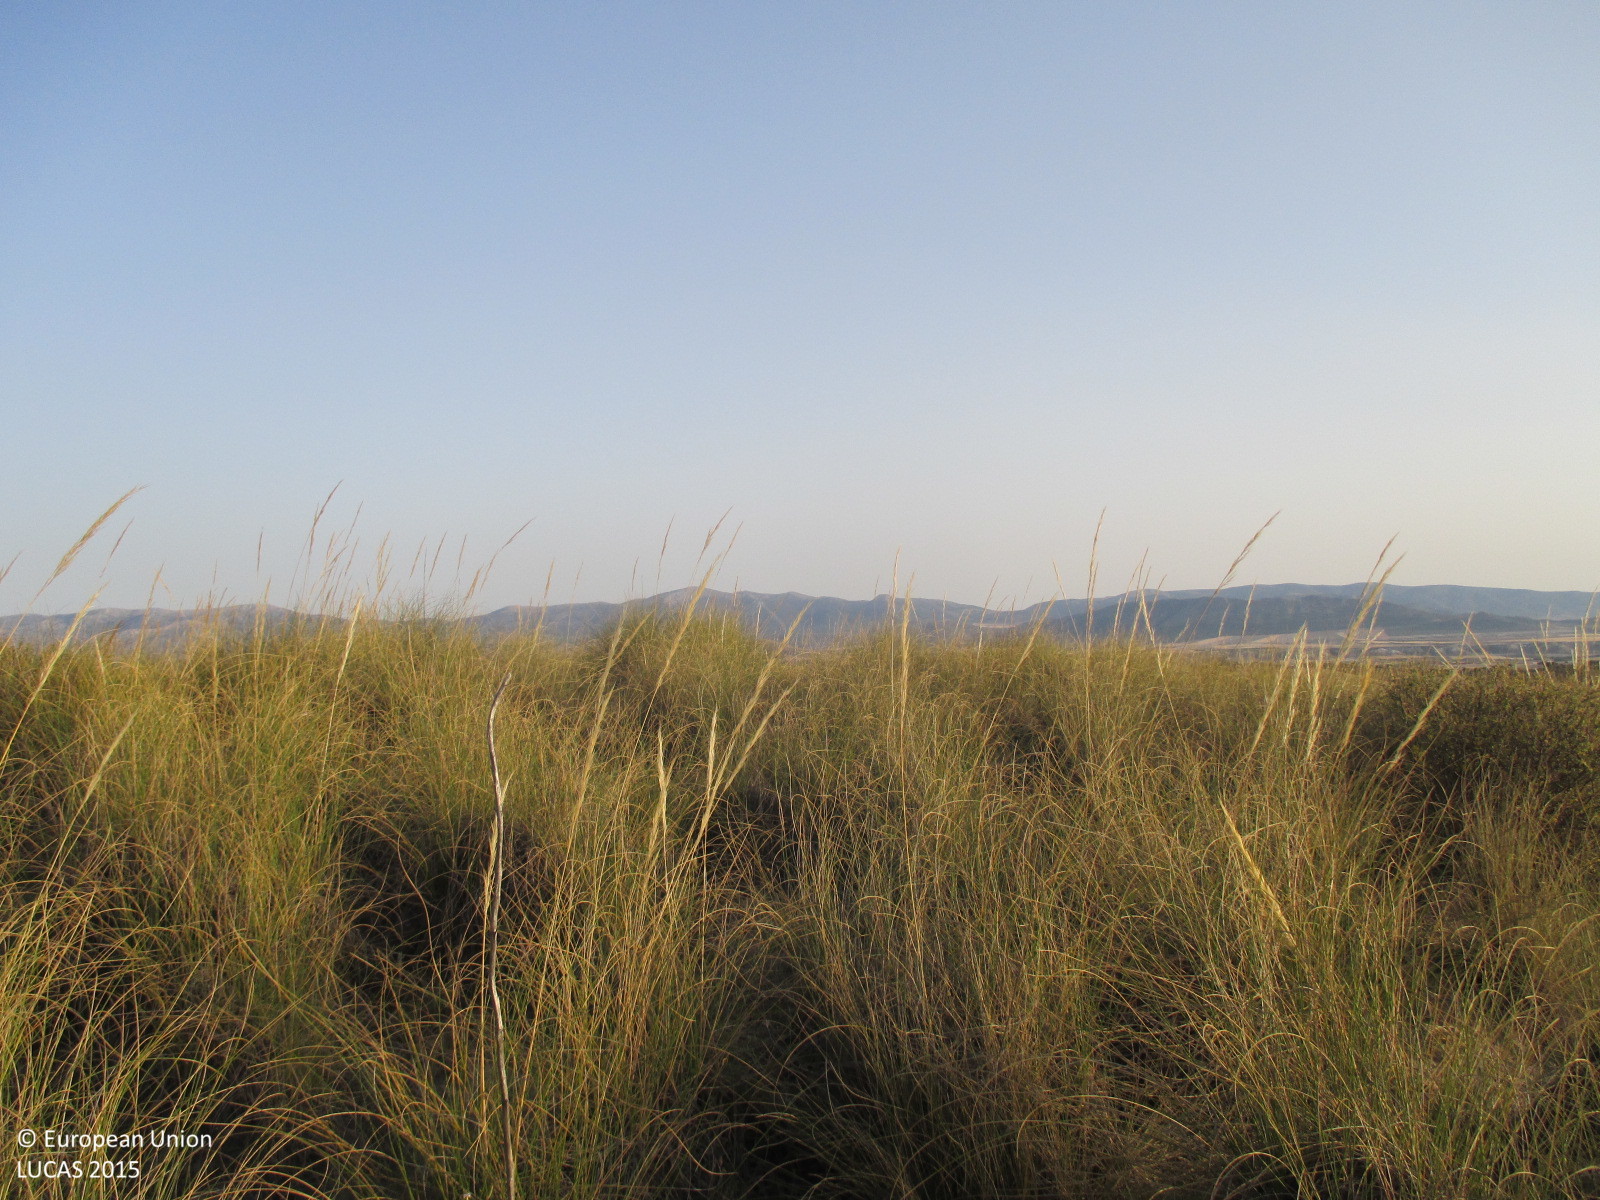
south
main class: Grassland
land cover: Grassland without tree/shrub cover
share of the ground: > 75 %
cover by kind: herbaceous plants 90 %, consolidated bare surface 5 %, unconsolidated bare surface 5 %
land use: Semi-natural and natural areas not in use
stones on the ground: < 10 %
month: June
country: ES
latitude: 37.7787
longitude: -2.3754
